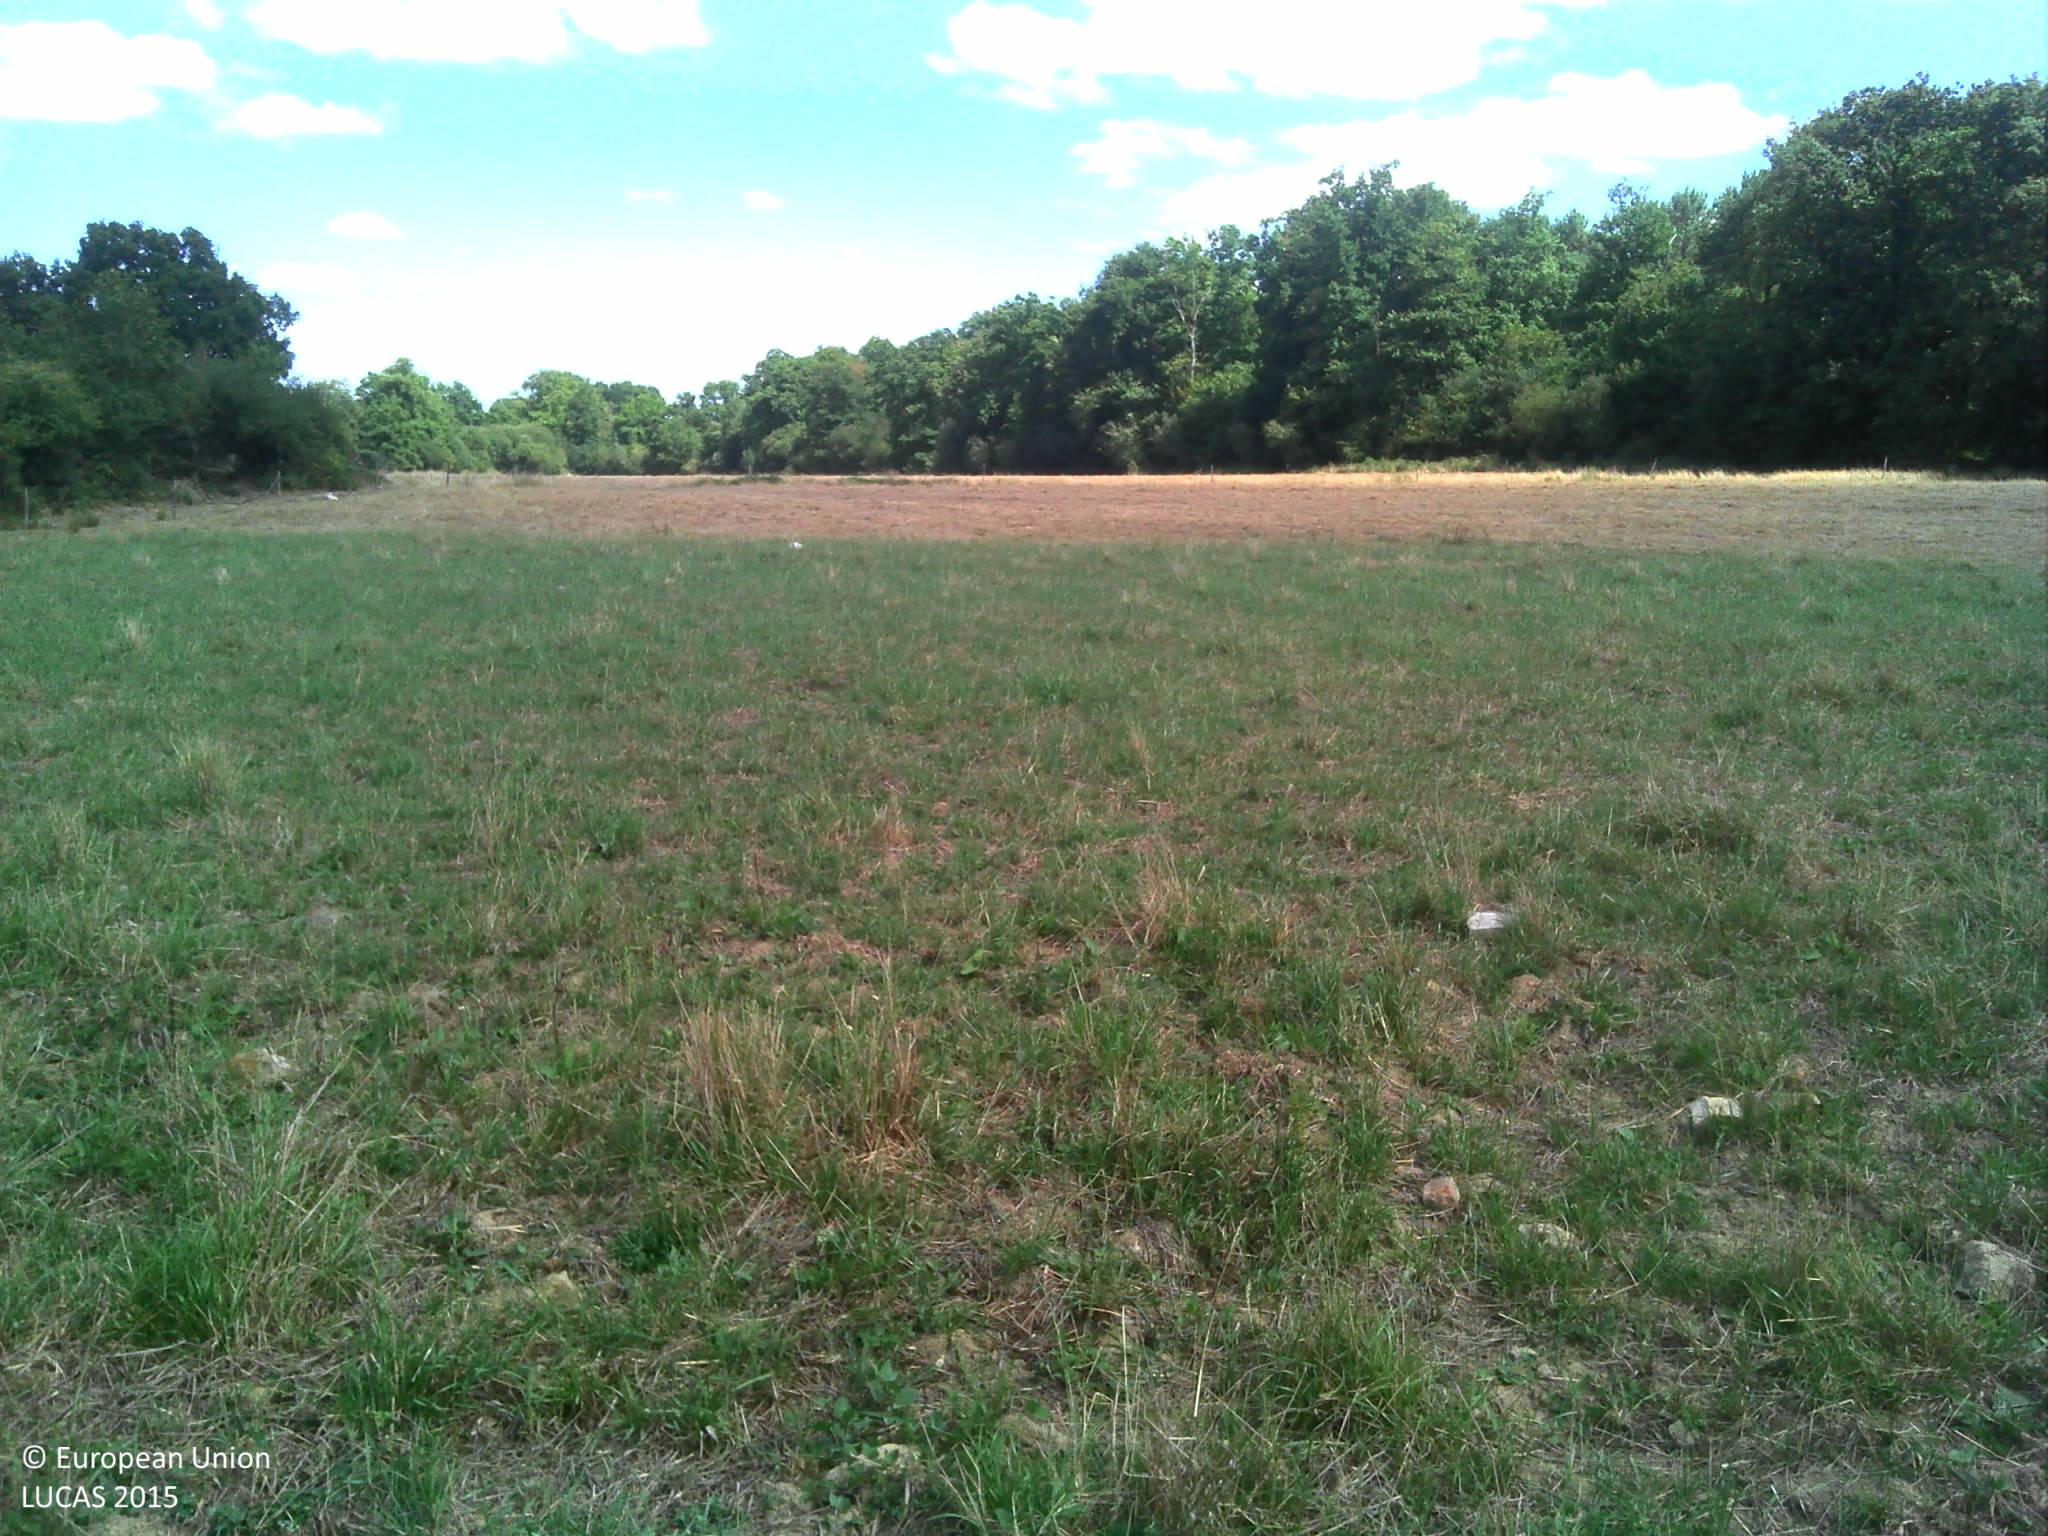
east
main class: Grassland
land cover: Grassland without tree/shrub cover
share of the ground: > 75 %
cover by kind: herbaceous plants 100 %
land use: Agriculture (excluding fallow land and kitchen gardens)
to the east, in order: Grassland without tree/shrub cover
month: August
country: FR
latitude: 46.6905
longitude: -1.3476
